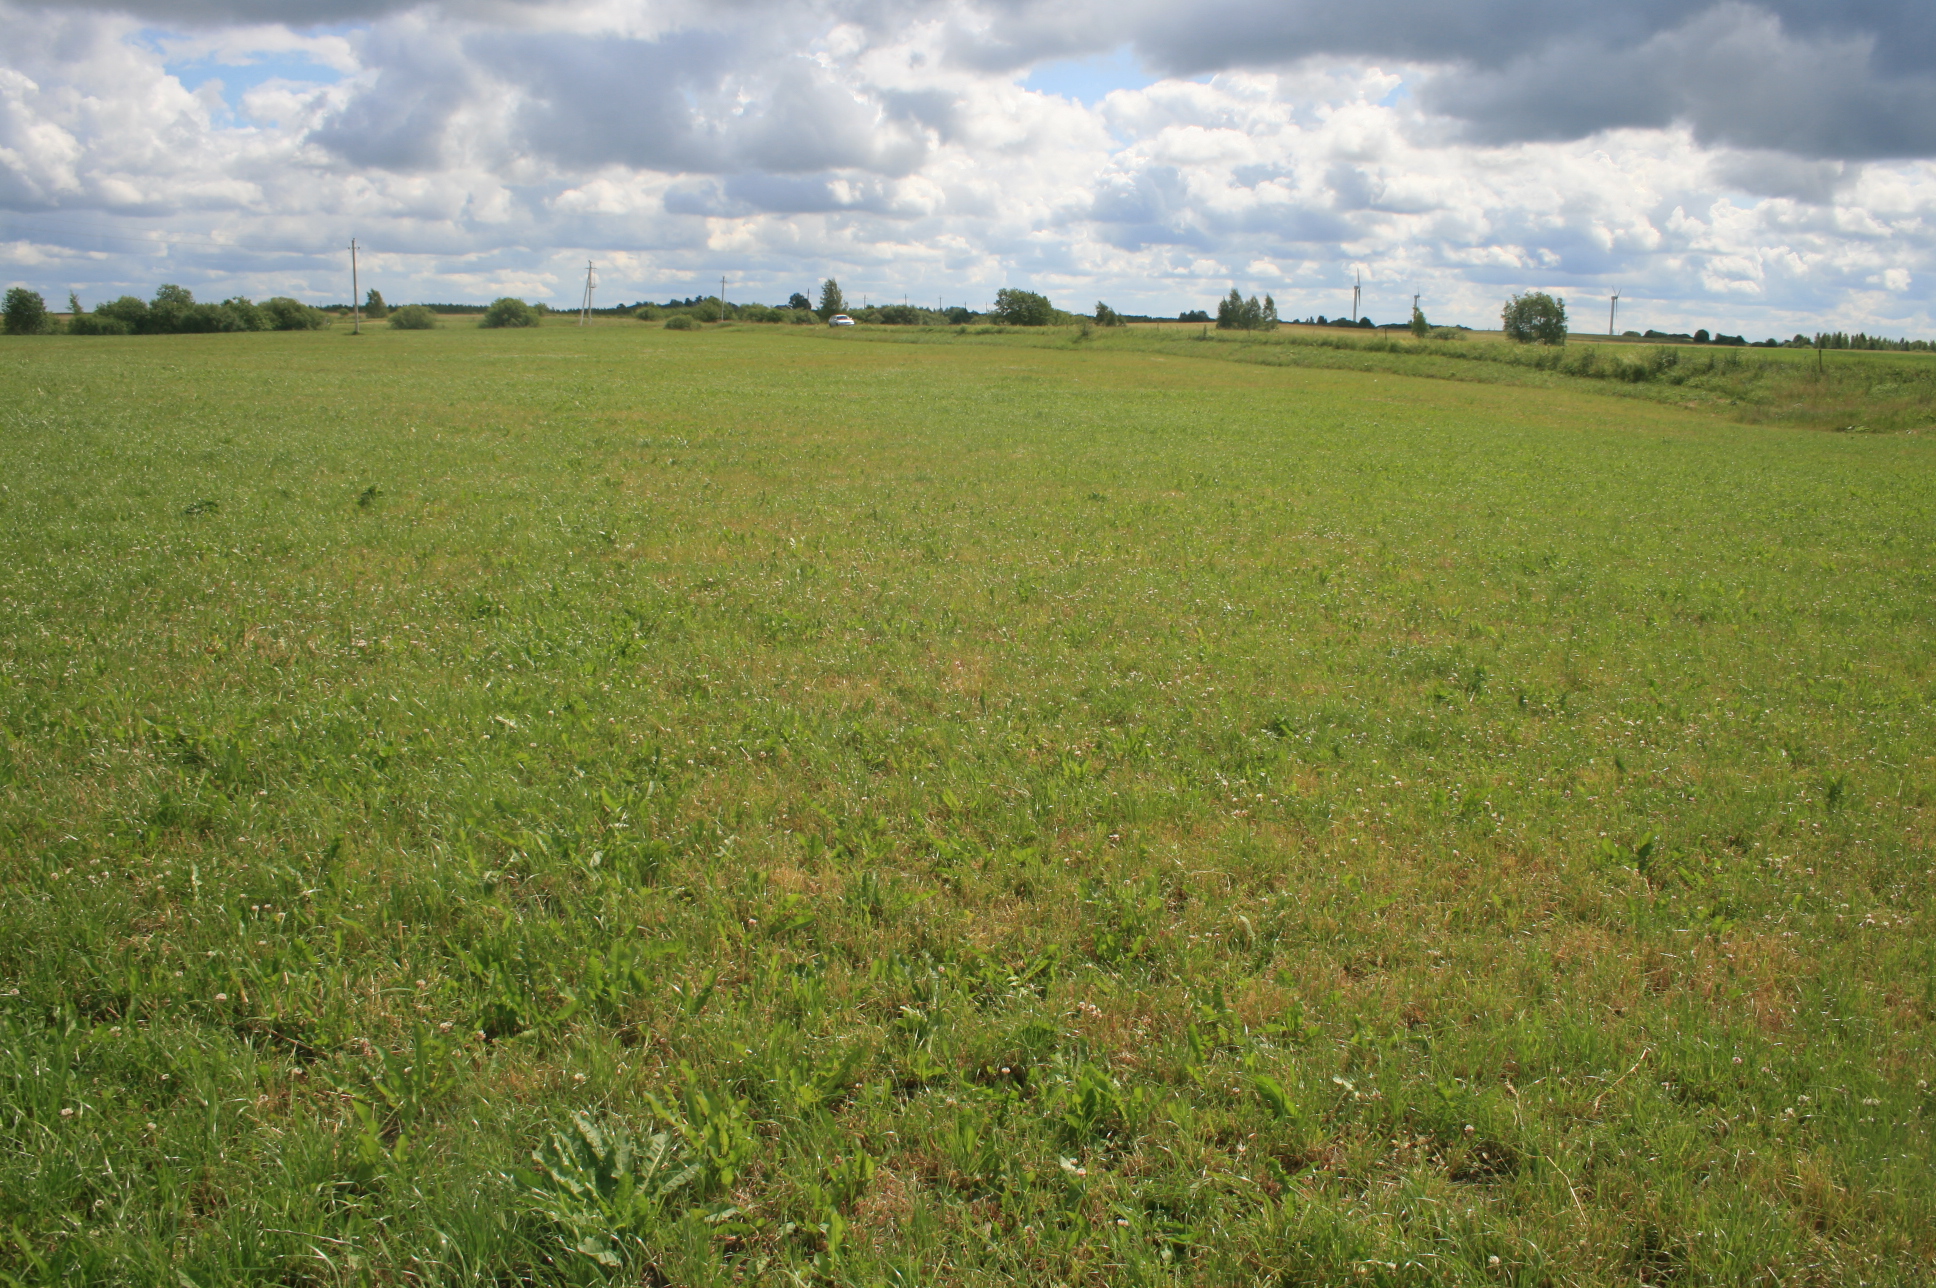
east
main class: Grassland
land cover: Grassland without tree/shrub cover
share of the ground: > 75 %
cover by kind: herbaceous plants 100 %
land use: Agriculture (excluding fallow land and kitchen gardens)
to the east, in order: Grassland without tree/shrub cover; Fences; Grassland without tree/shrub cover; Paved roads, cycling and walking lanes; Grassland without tree/shrub cover; Fences; Grassland without tree/shrub cover
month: June
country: LT
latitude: 55.2143
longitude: 22.0786
